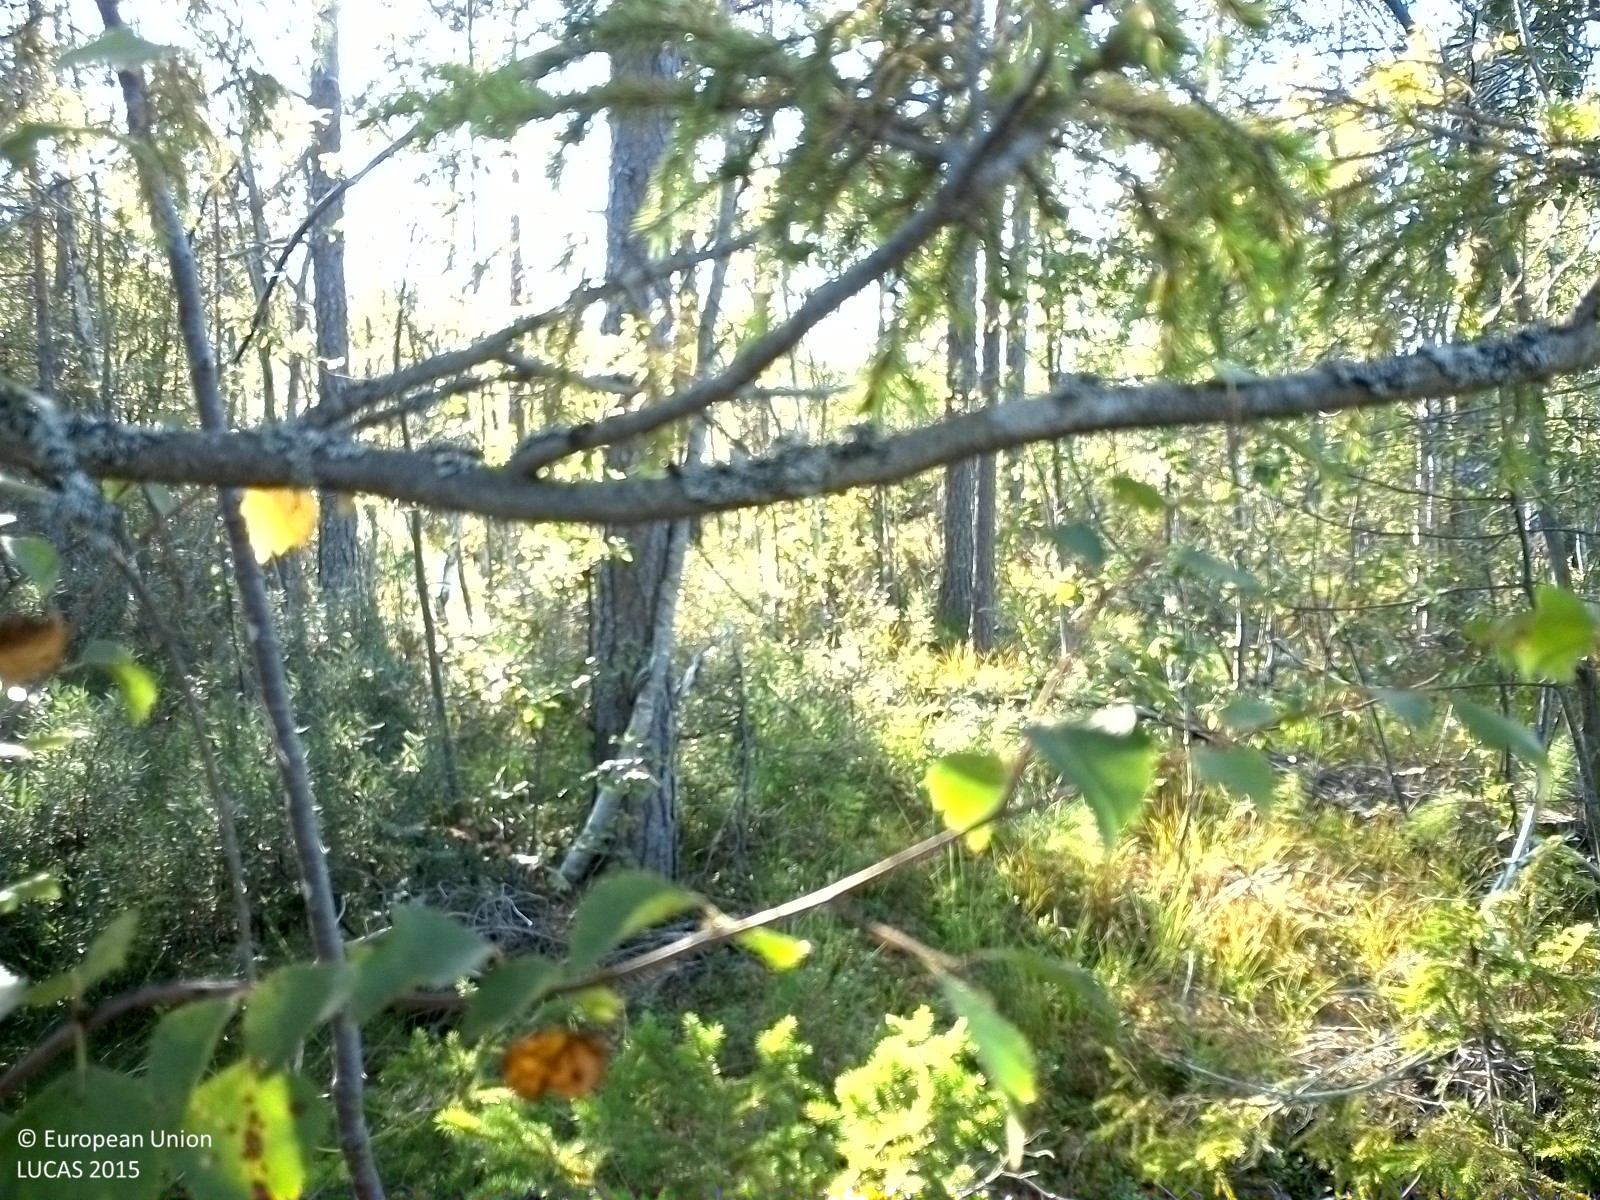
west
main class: Woodland
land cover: Other mixed woodland
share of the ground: 50 - 75 %
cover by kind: coniferous forest trees 30 %, broadleaved forest trees 20 %, herbaceous plants 20 %, lichens and mosses 20 %, shrubs 10 %
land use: Forestry
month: August
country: SE
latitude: 62.6058
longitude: 17.8704
